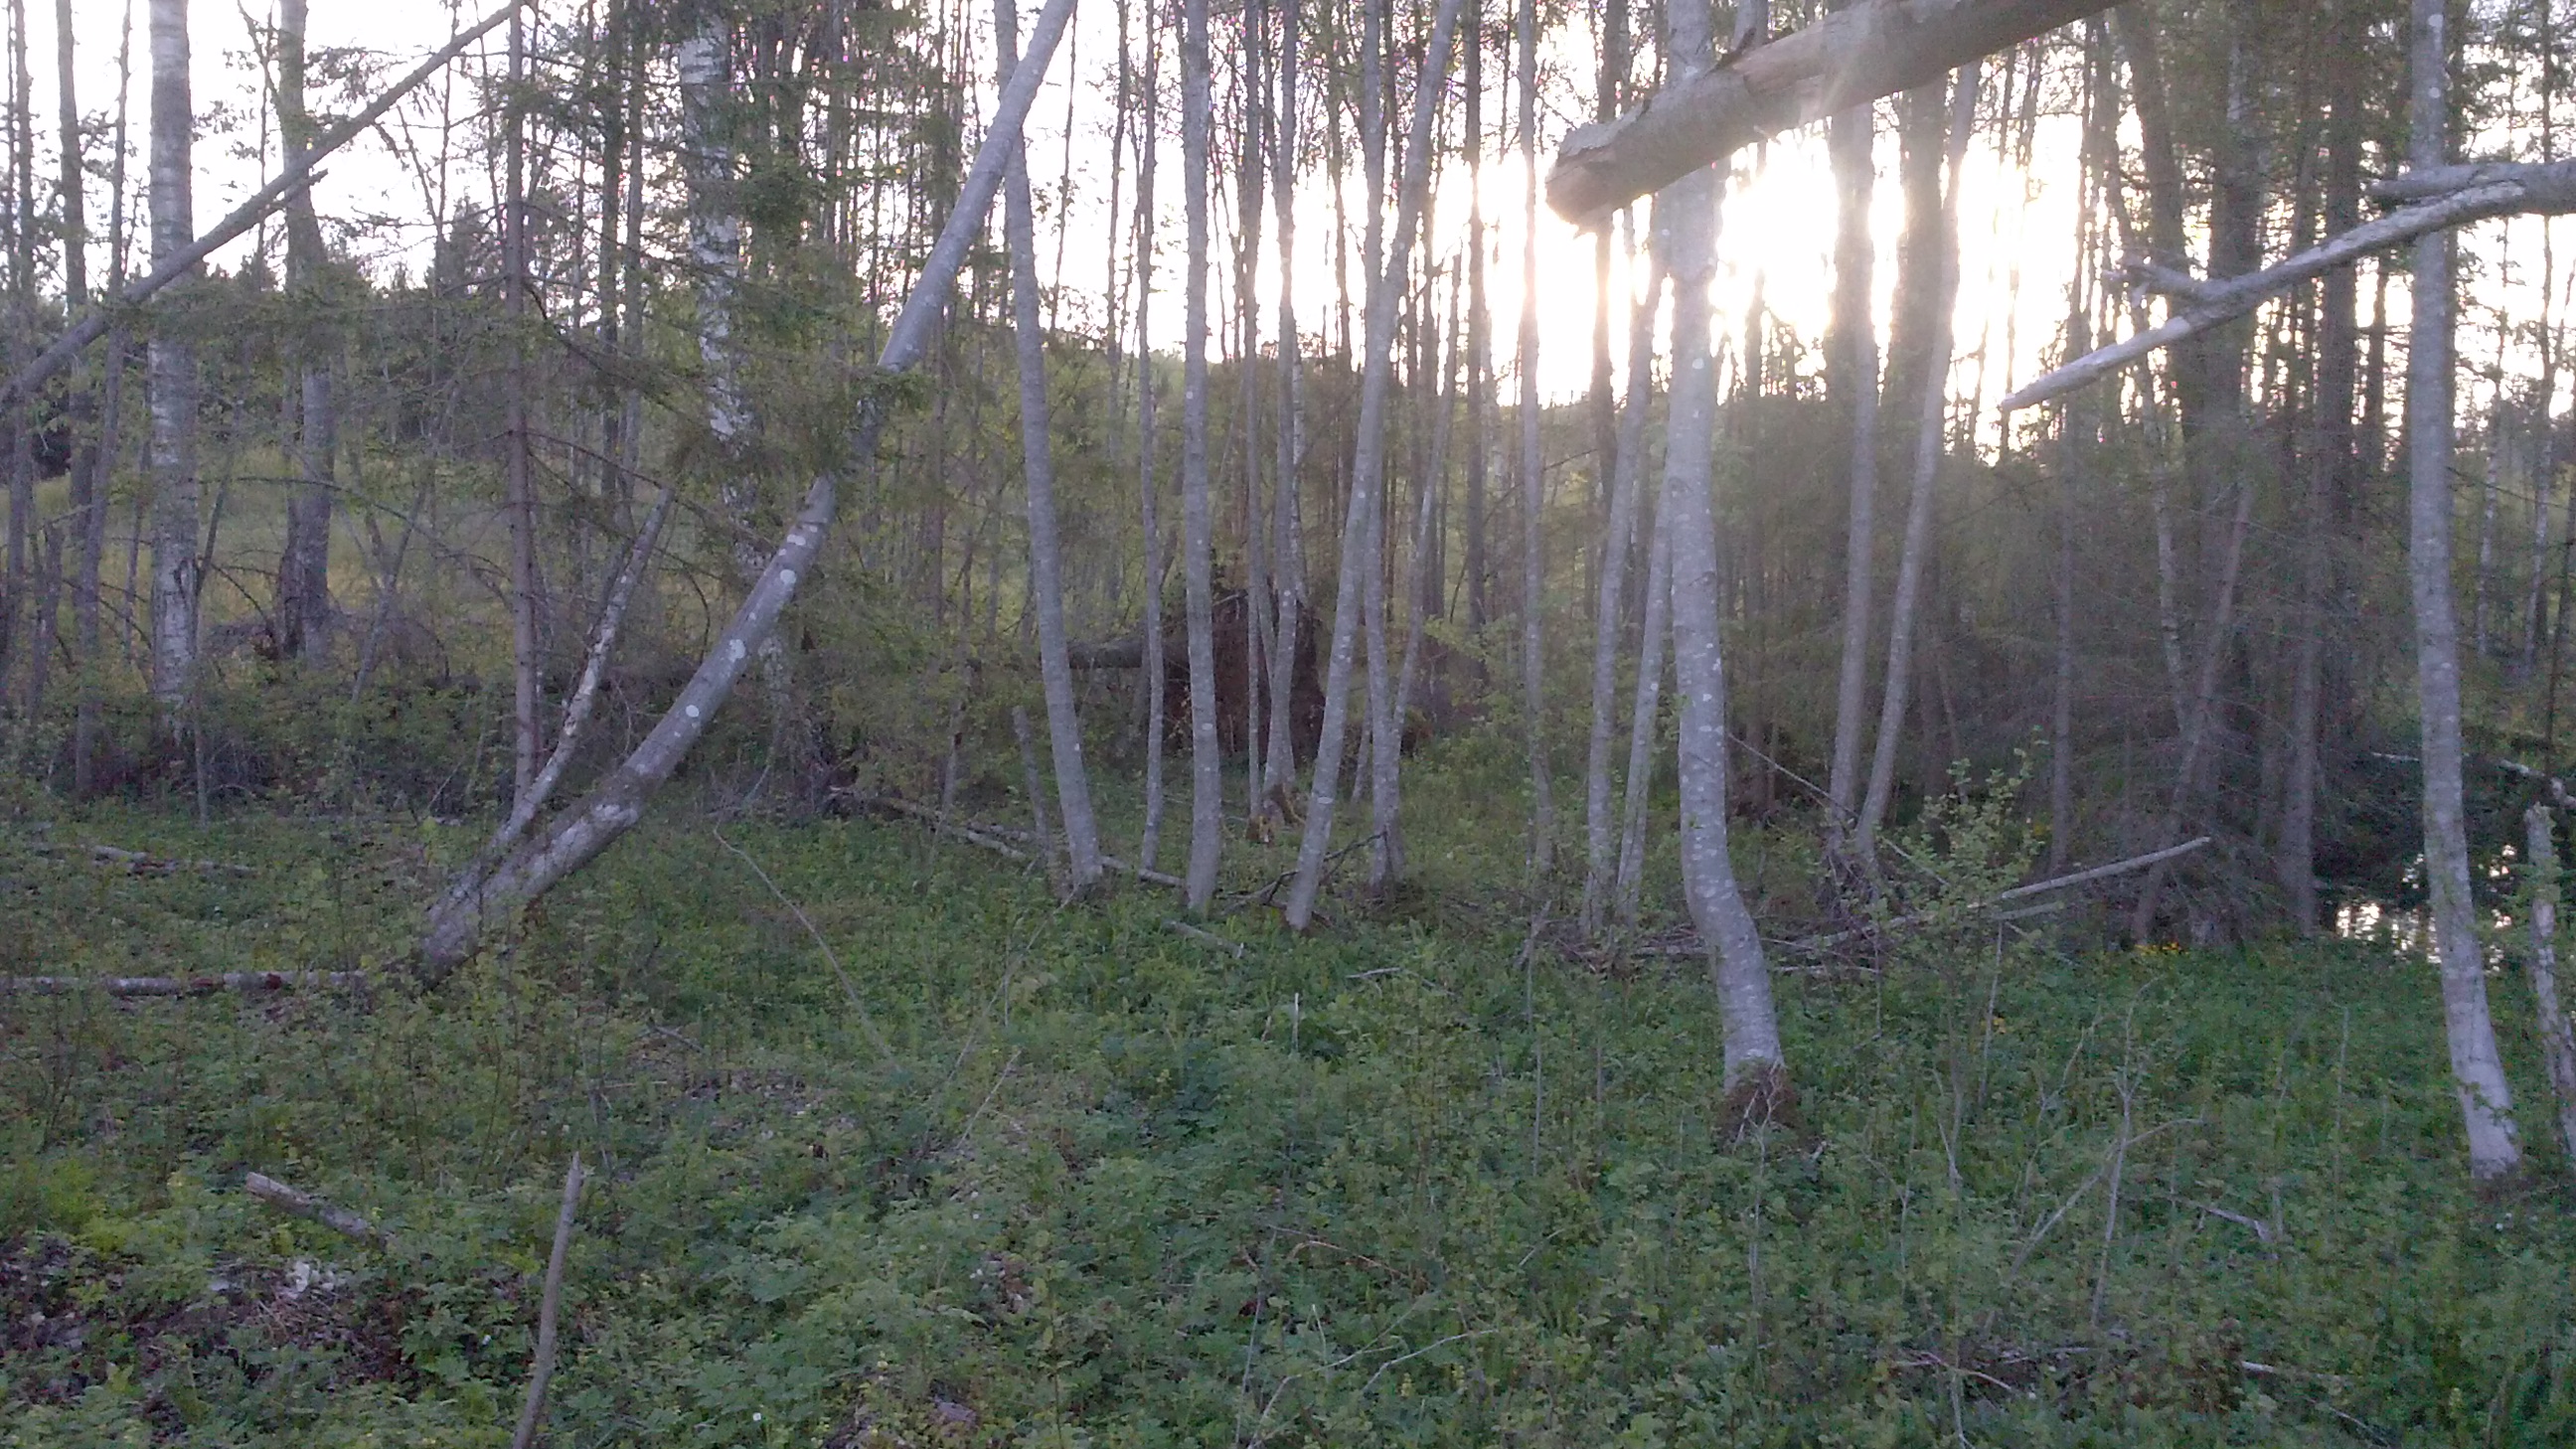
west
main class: Woodland
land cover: Broadleaved woodland
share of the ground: 50 - 75 %
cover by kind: broadleaved forest trees 50 %, shrubs 50 %
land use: Forestry
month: May
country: LV
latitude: 56.0707
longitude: 27.8143
